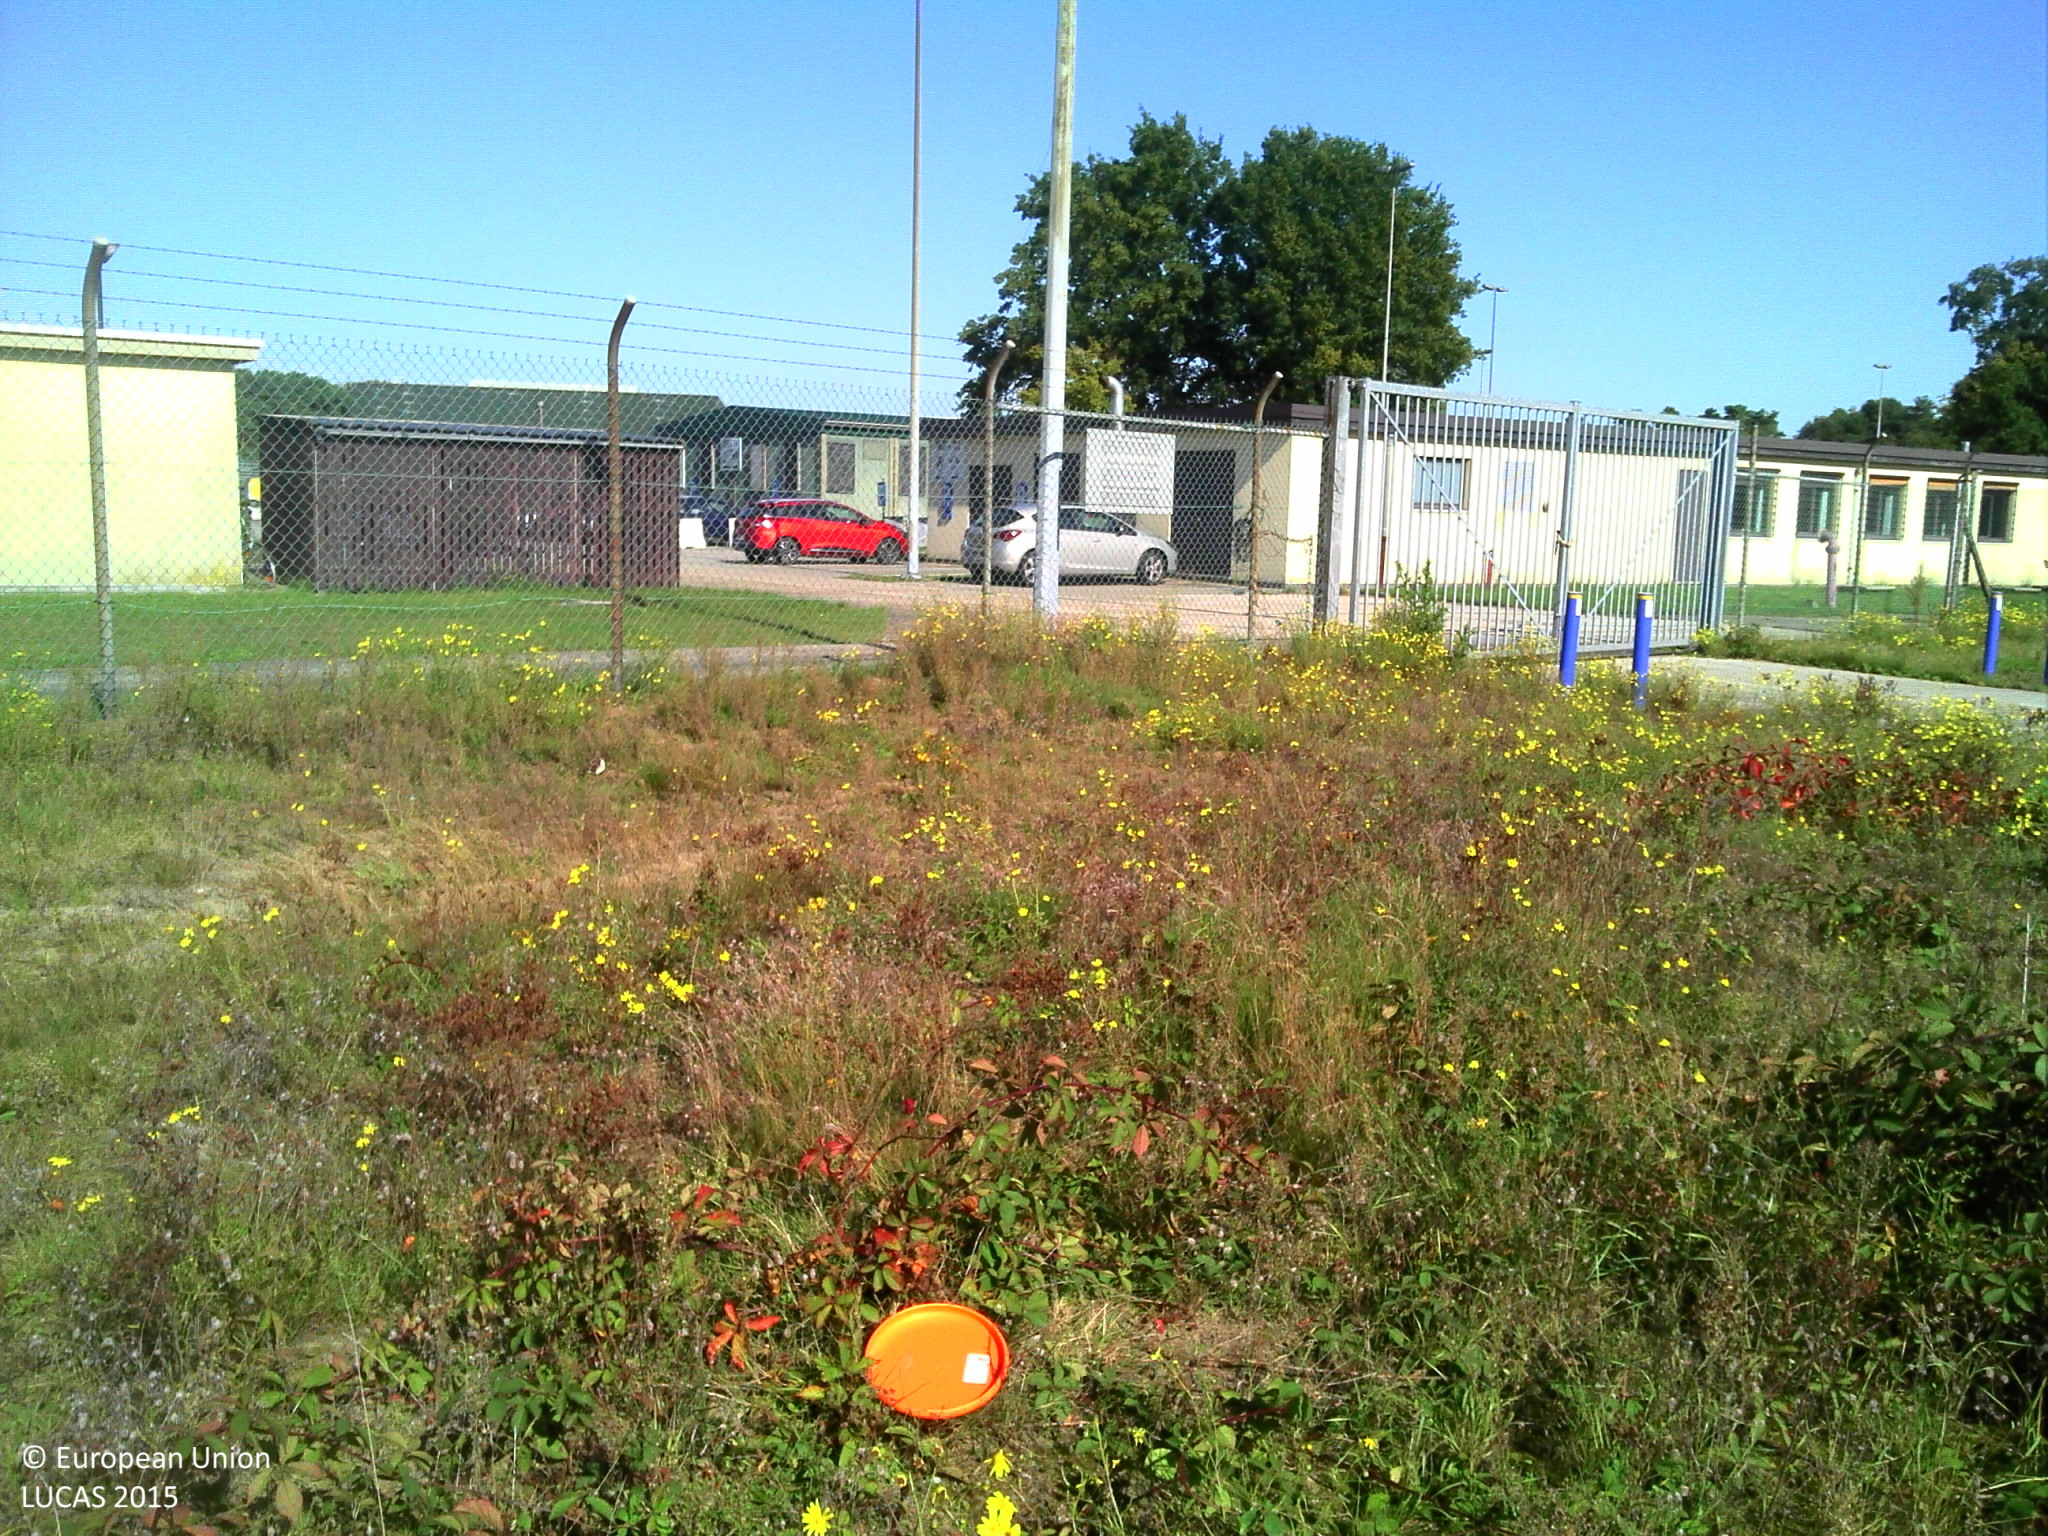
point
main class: Grassland
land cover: Spontaneously vegetated surfaces
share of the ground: > 75 %
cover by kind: herbaceous plants 80 %, unconsolidated bare surface 20 %
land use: Semi-natural and natural areas not in use
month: September
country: BE
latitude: 51.1803
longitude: 4.7464
